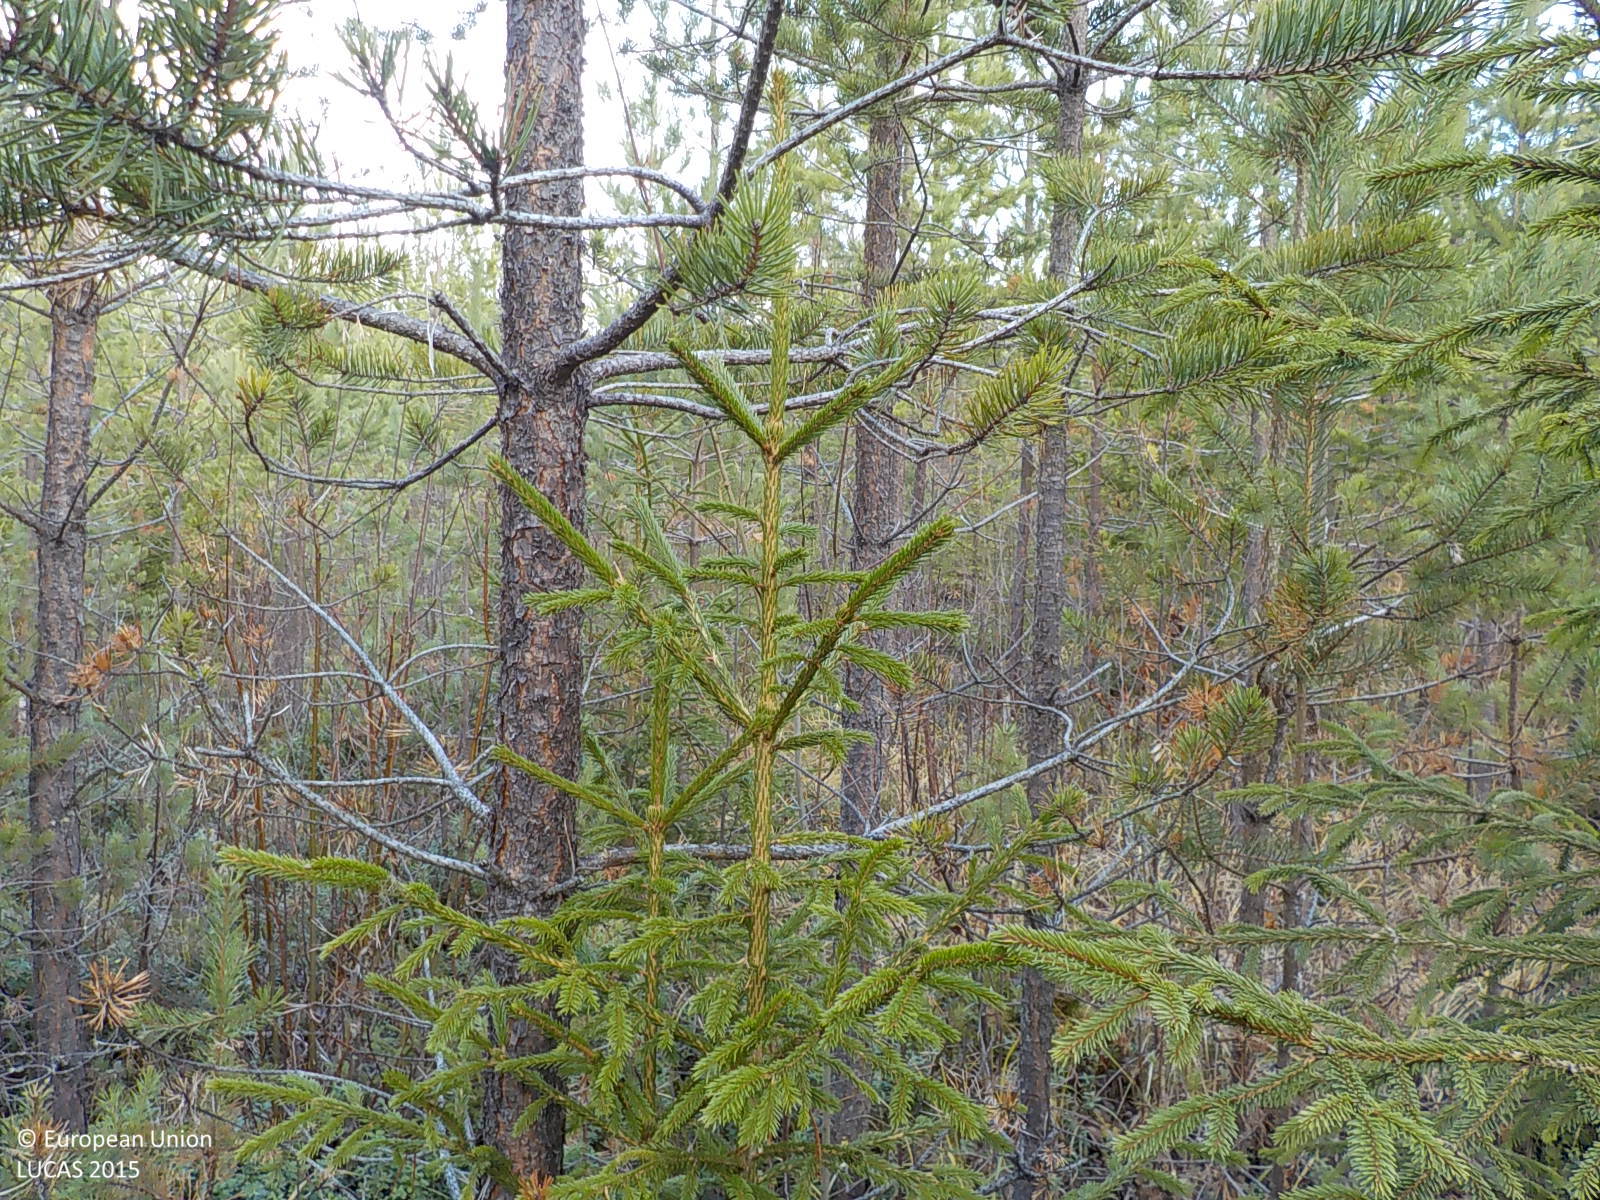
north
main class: Woodland
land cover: Pine dominated coniferous woodland
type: boreal forest
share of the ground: > 75 %
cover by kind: coniferous forest trees 85 %, shrubs 10 %, herbaceous plants 5 %
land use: Forestry
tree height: > 5 m
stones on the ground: < 10 %
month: October
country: SE
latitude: 63.3379
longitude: 16.9858
